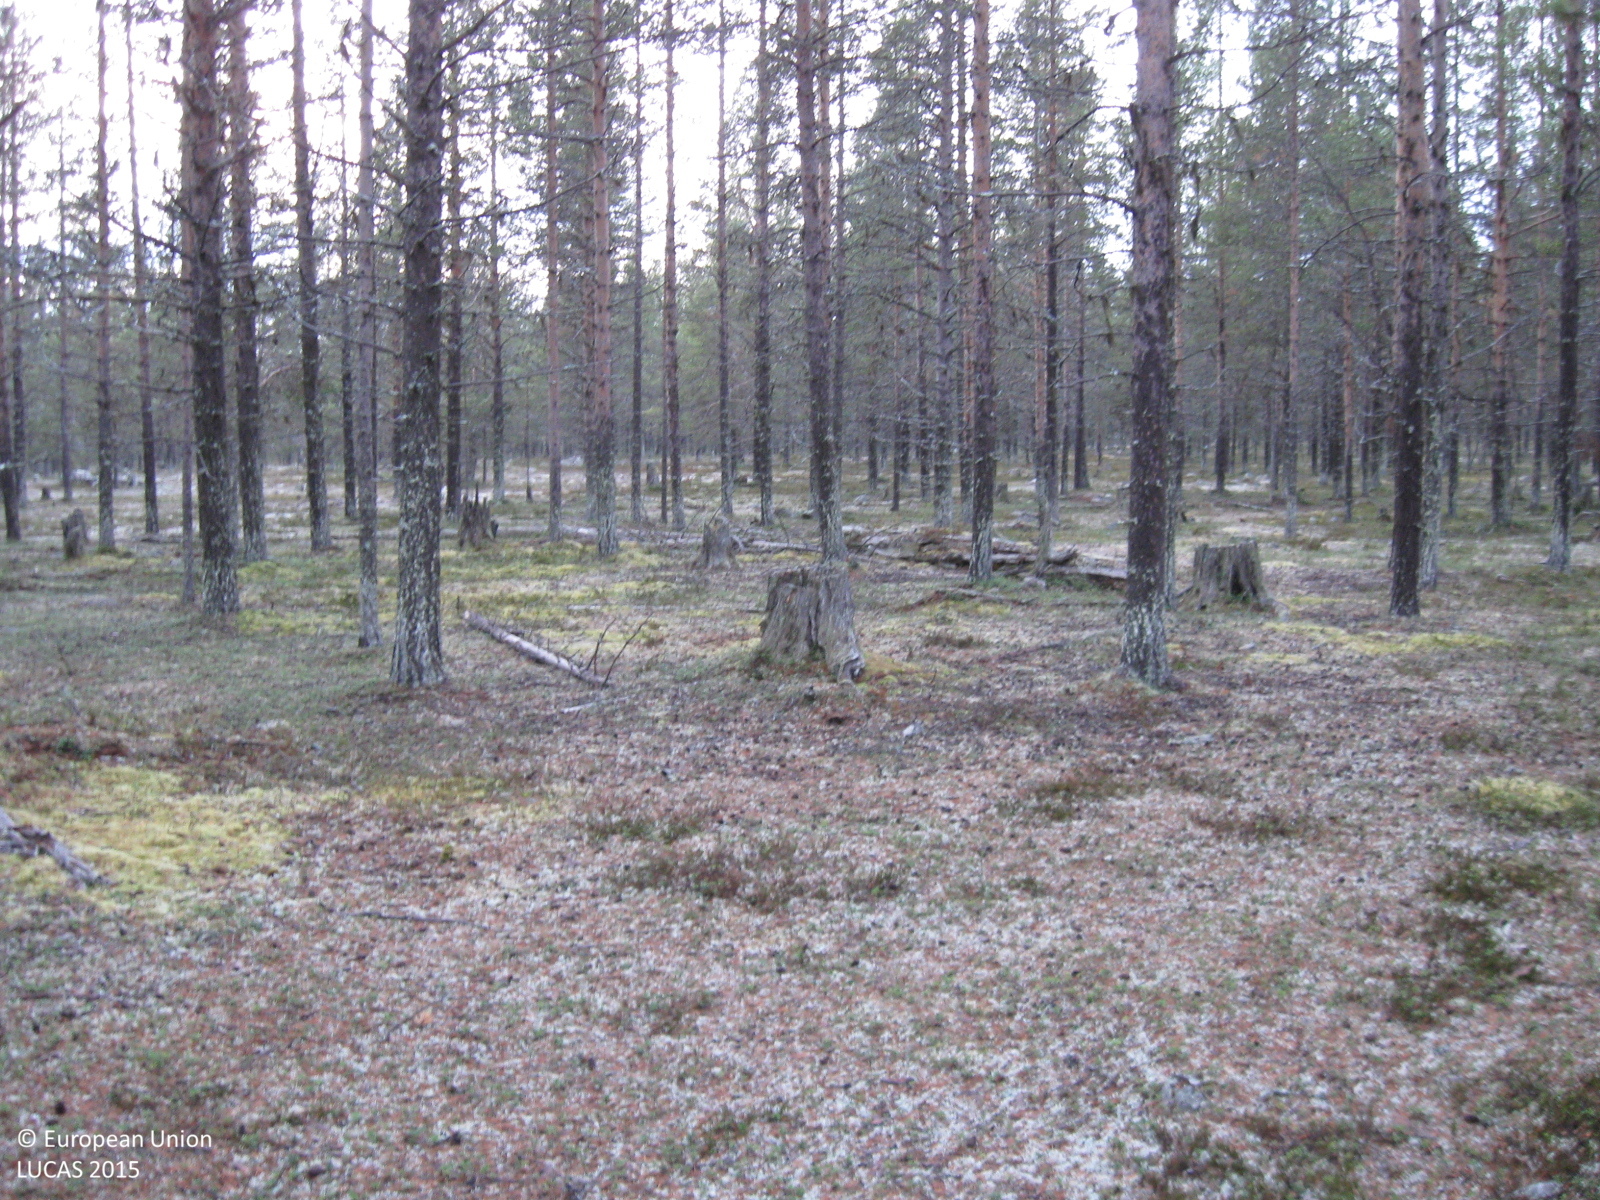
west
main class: Woodland
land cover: Pine dominated coniferous woodland
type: boreal forest
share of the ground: 50 - 75 %
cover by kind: coniferous forest trees 50 %, shrubs 20 %, lichens and mosses 20 %, herbaceous plants 5 %, unconsolidated bare surface 5 %
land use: Forestry
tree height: > 5 m
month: October
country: SE
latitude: 66.6094
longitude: 21.0413
